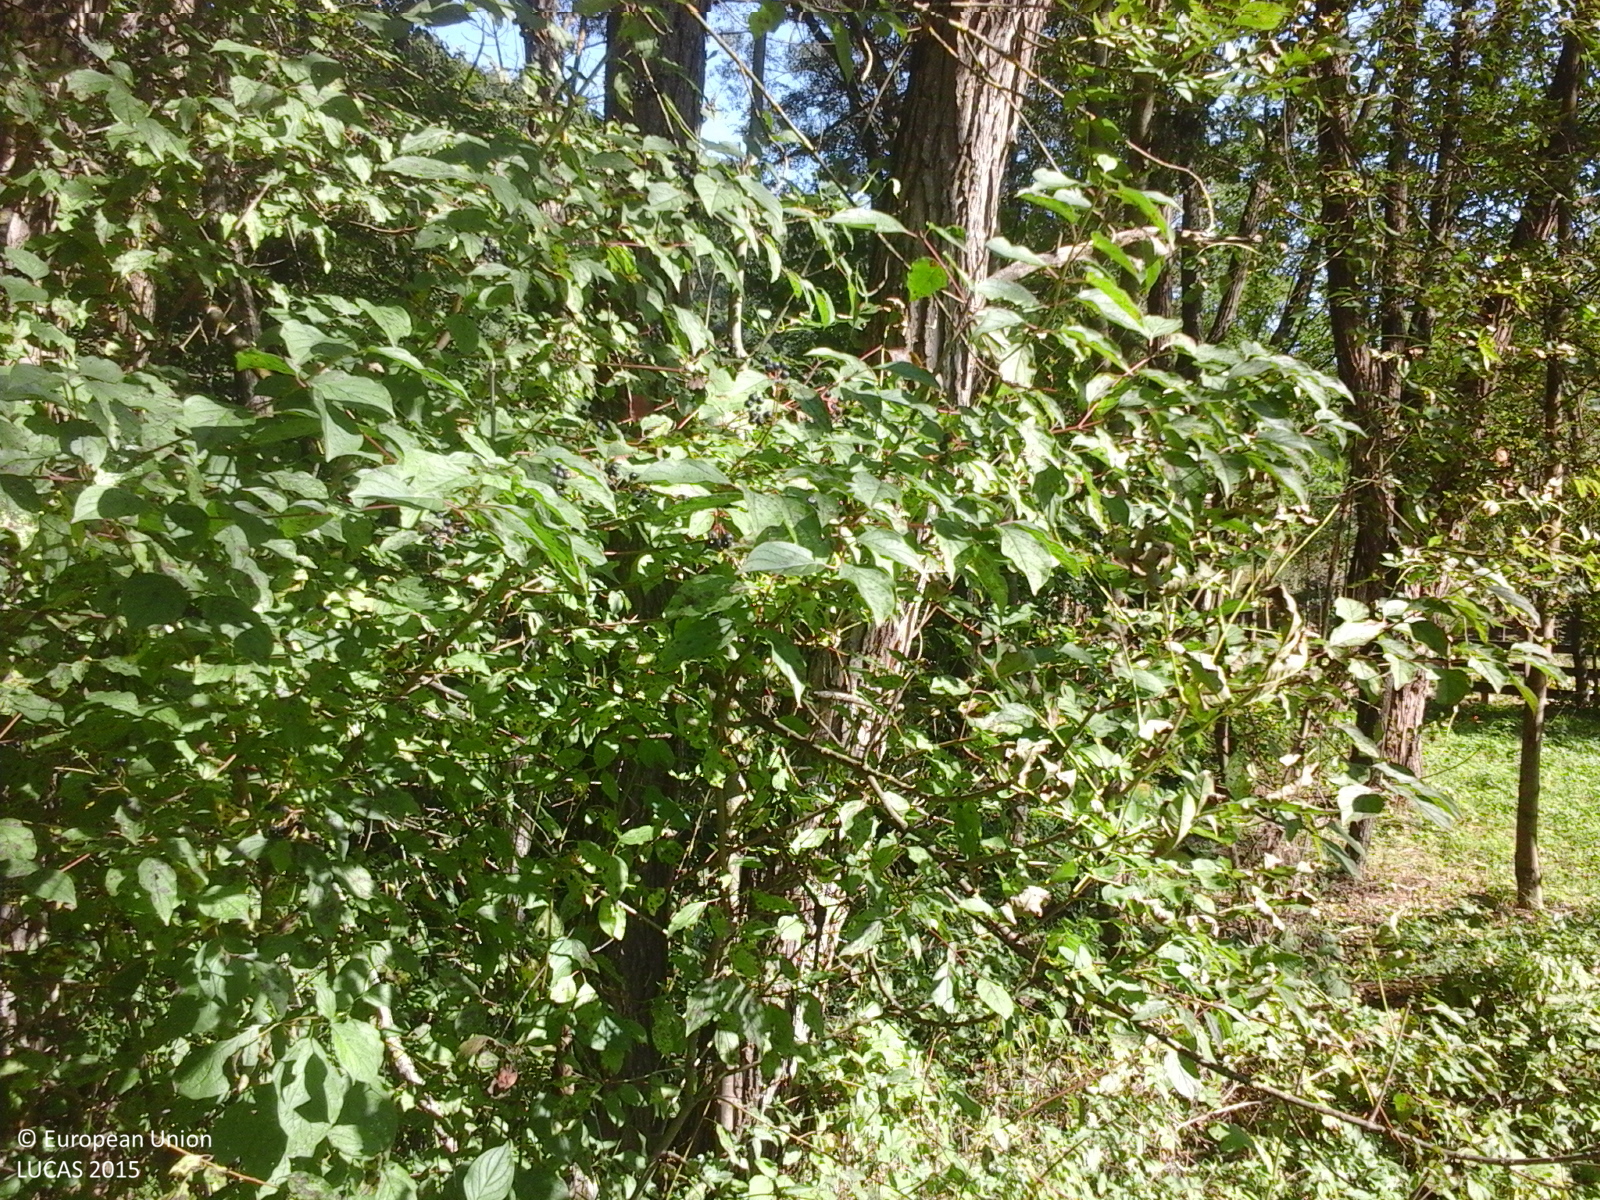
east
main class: Woodland
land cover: Broadleaved woodland
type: exotic forest
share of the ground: > 75 %
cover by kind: broadleaved forest trees 80 %, herbaceous plants 20 %
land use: Forestry
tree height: > 5 m
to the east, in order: Broadleaved woodland; Grassland without tree/shrub cover; Artificial constructions in urban areas; Broadleaved woodland
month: October
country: RO
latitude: 46.5120
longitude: 23.5050
